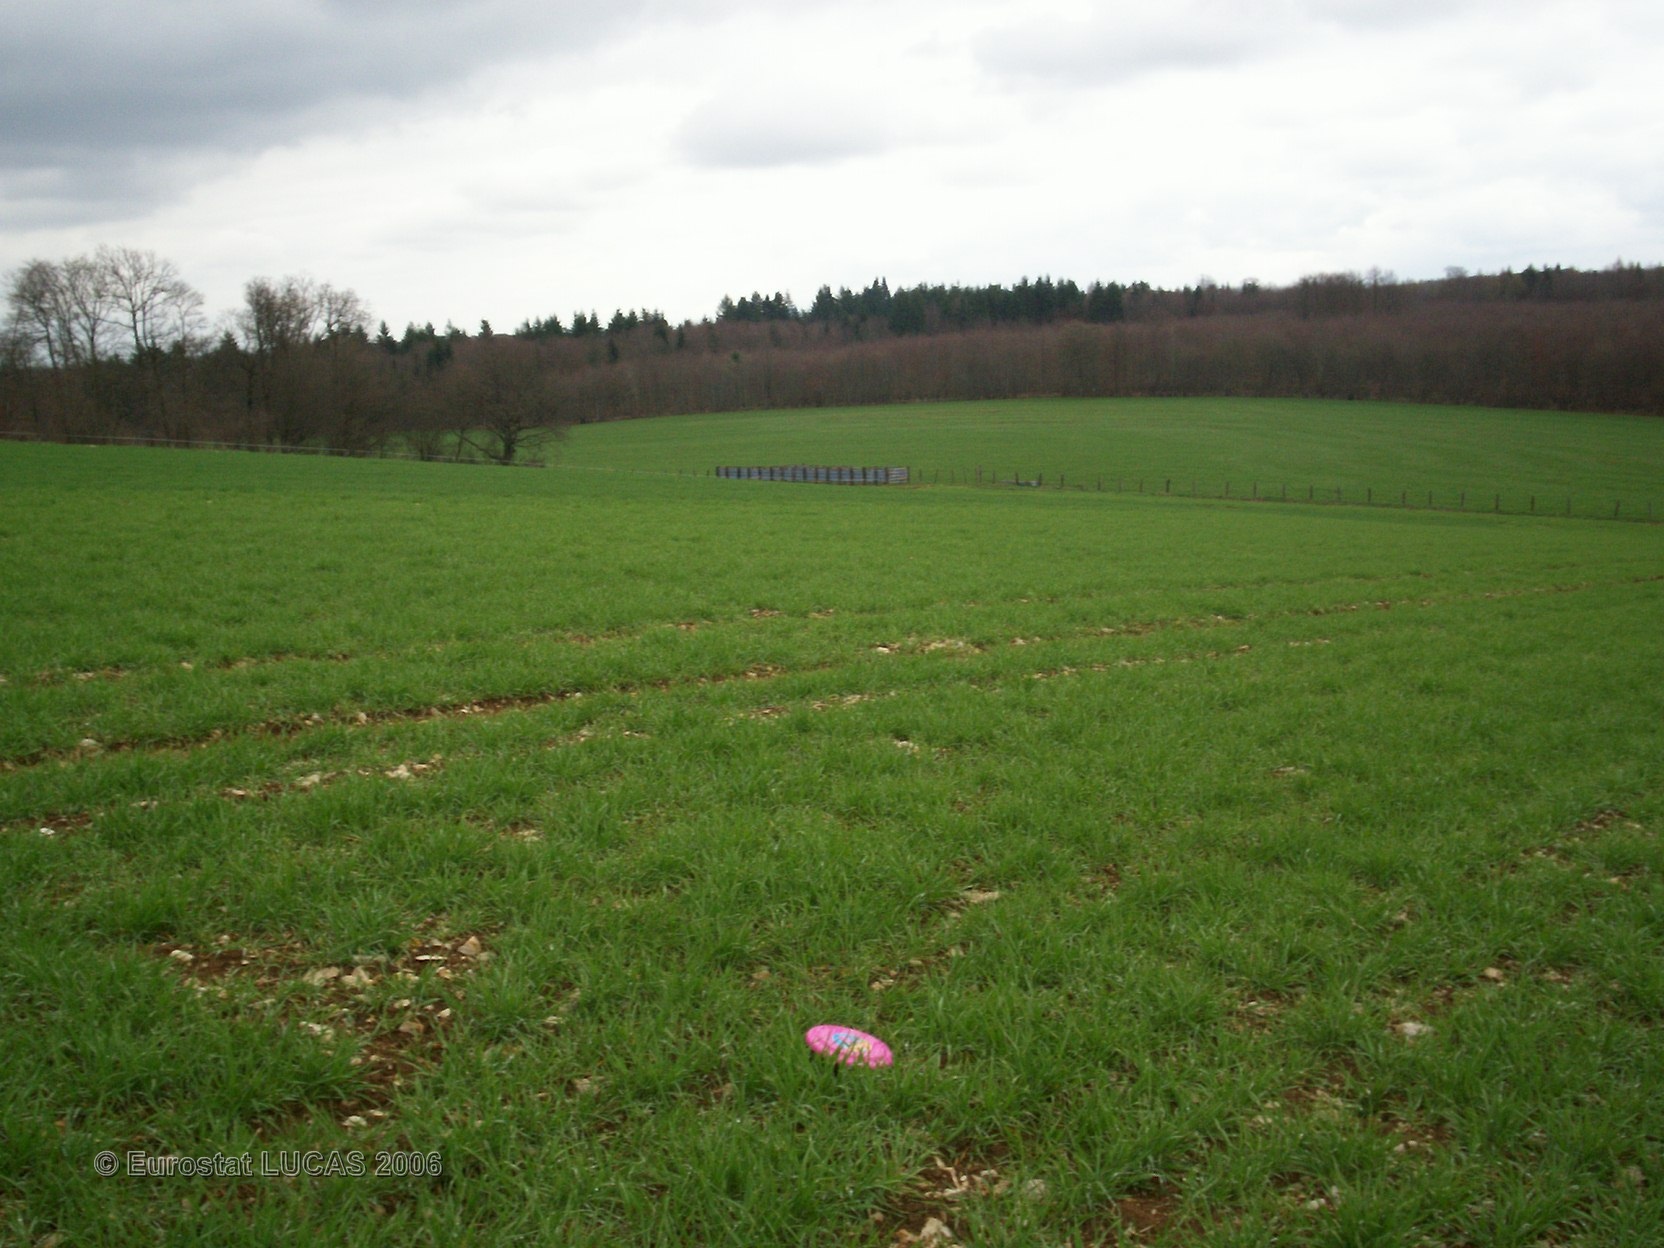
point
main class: Cropland
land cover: Barley
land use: Agriculture (excluding fallow land and kitchen gardens)
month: April
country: FR
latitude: 48.3034
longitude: 4.8889
